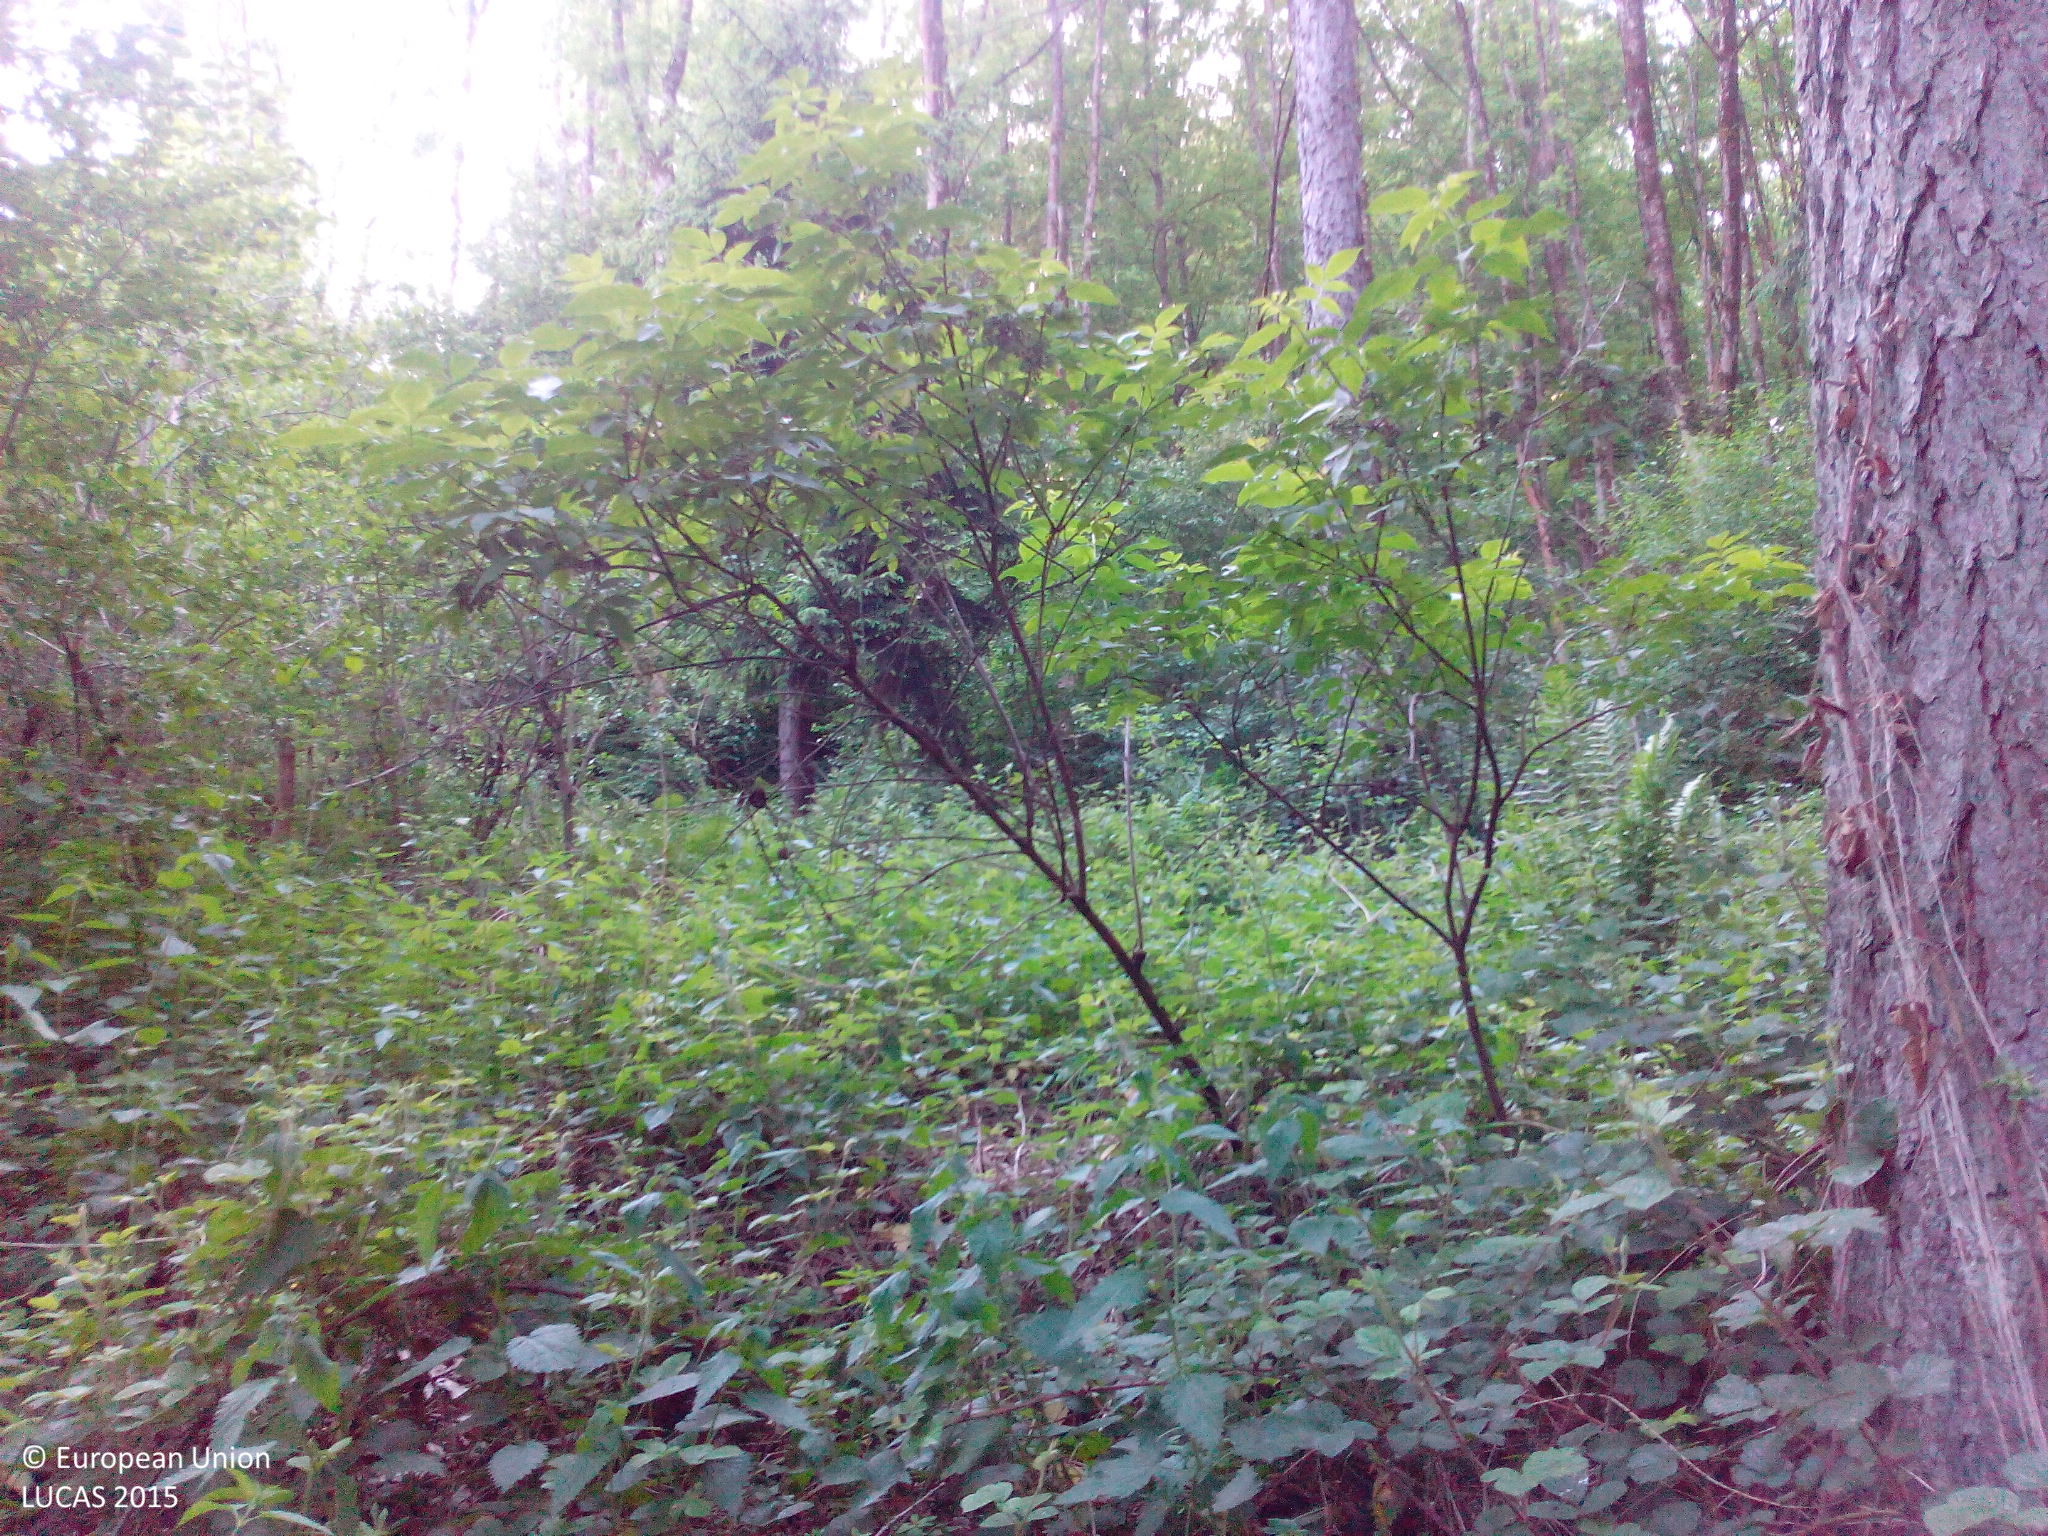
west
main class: Woodland
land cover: Broadleaved woodland
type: mesophytic deciduous forest
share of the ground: > 75 %
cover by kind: broadleaved forest trees 100 %
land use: Forestry
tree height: > 5 m
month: June
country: DE
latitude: 51.4072
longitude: 7.9733
